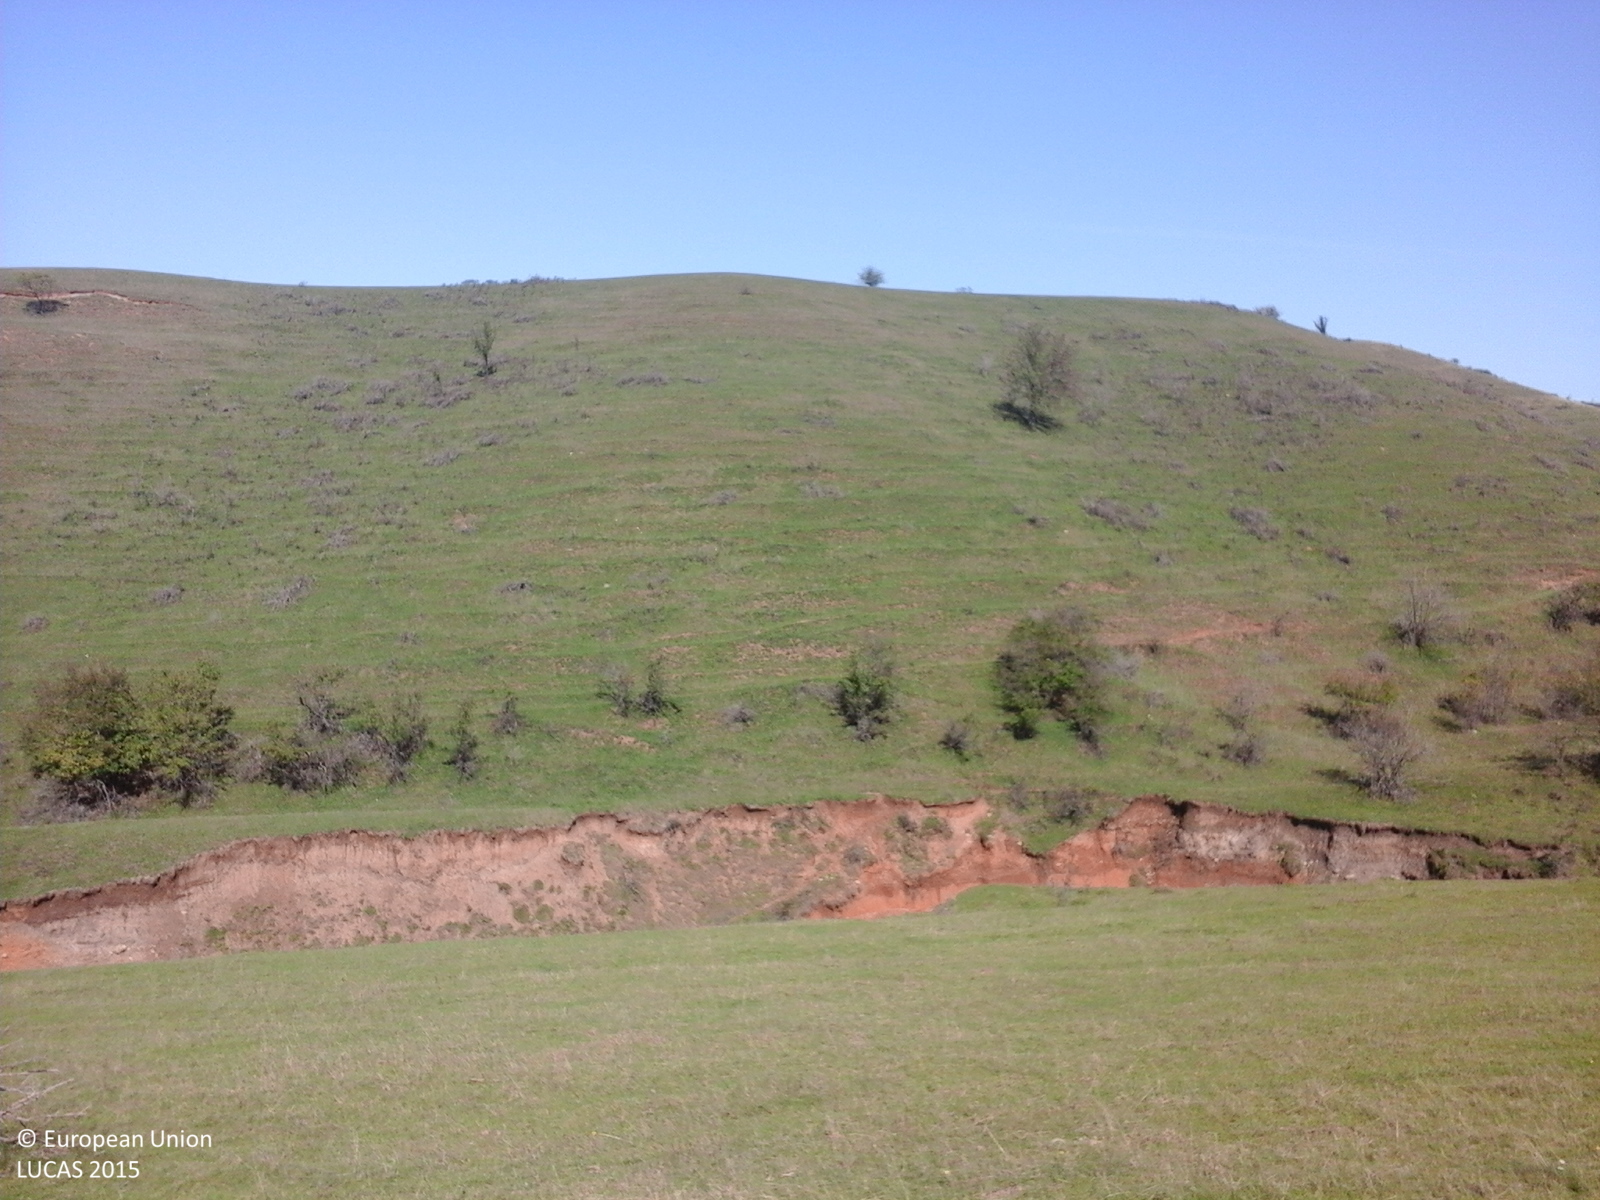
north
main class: Grassland
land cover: Grassland without tree/shrub cover
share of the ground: > 75 %
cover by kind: herbaceous plants 100 %
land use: Agriculture (excluding fallow land and kitchen gardens)
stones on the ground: < 10 %
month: October
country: RO
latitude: 46.5618
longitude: 23.5444
